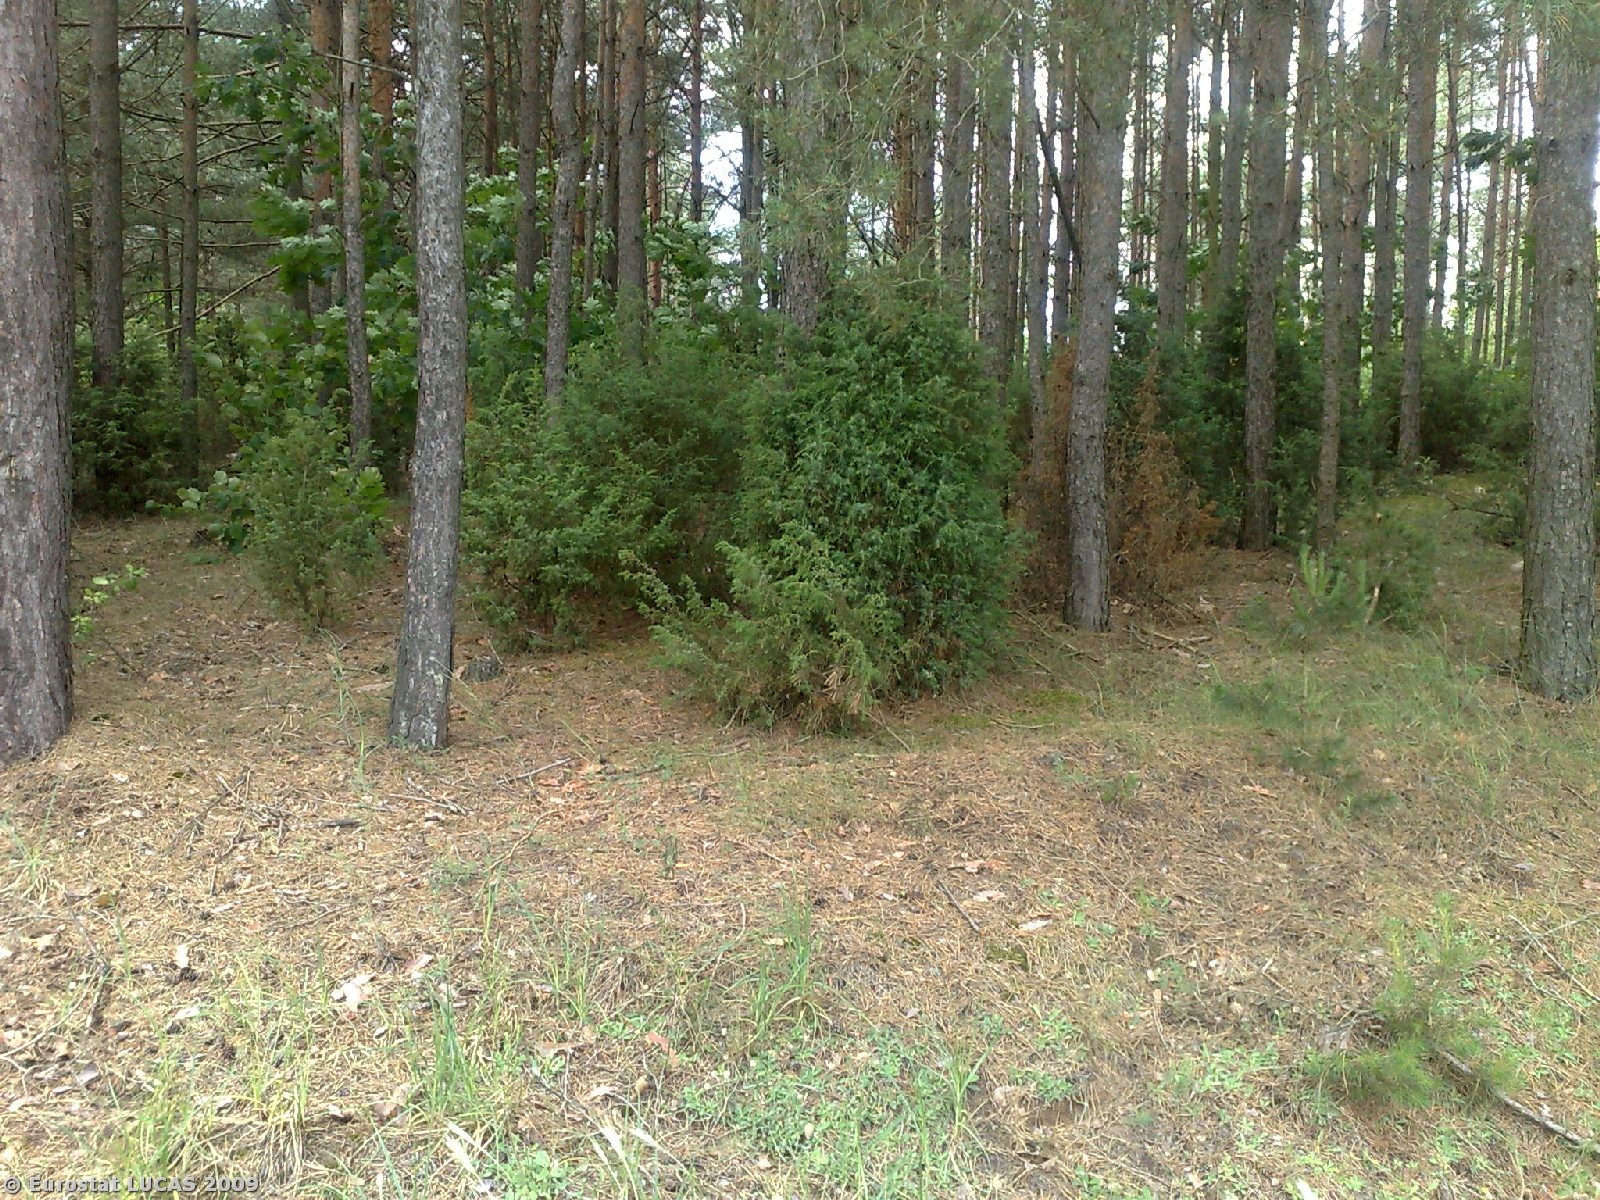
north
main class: Woodland
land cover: Coniferous woodland
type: hemiboreal forest and nemoral coniferous forest and mixed broadleaved-coniferous forest
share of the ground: > 75 %
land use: Forestry
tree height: > 5 m
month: June
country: PL
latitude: 53.7327
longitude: 23.5296
